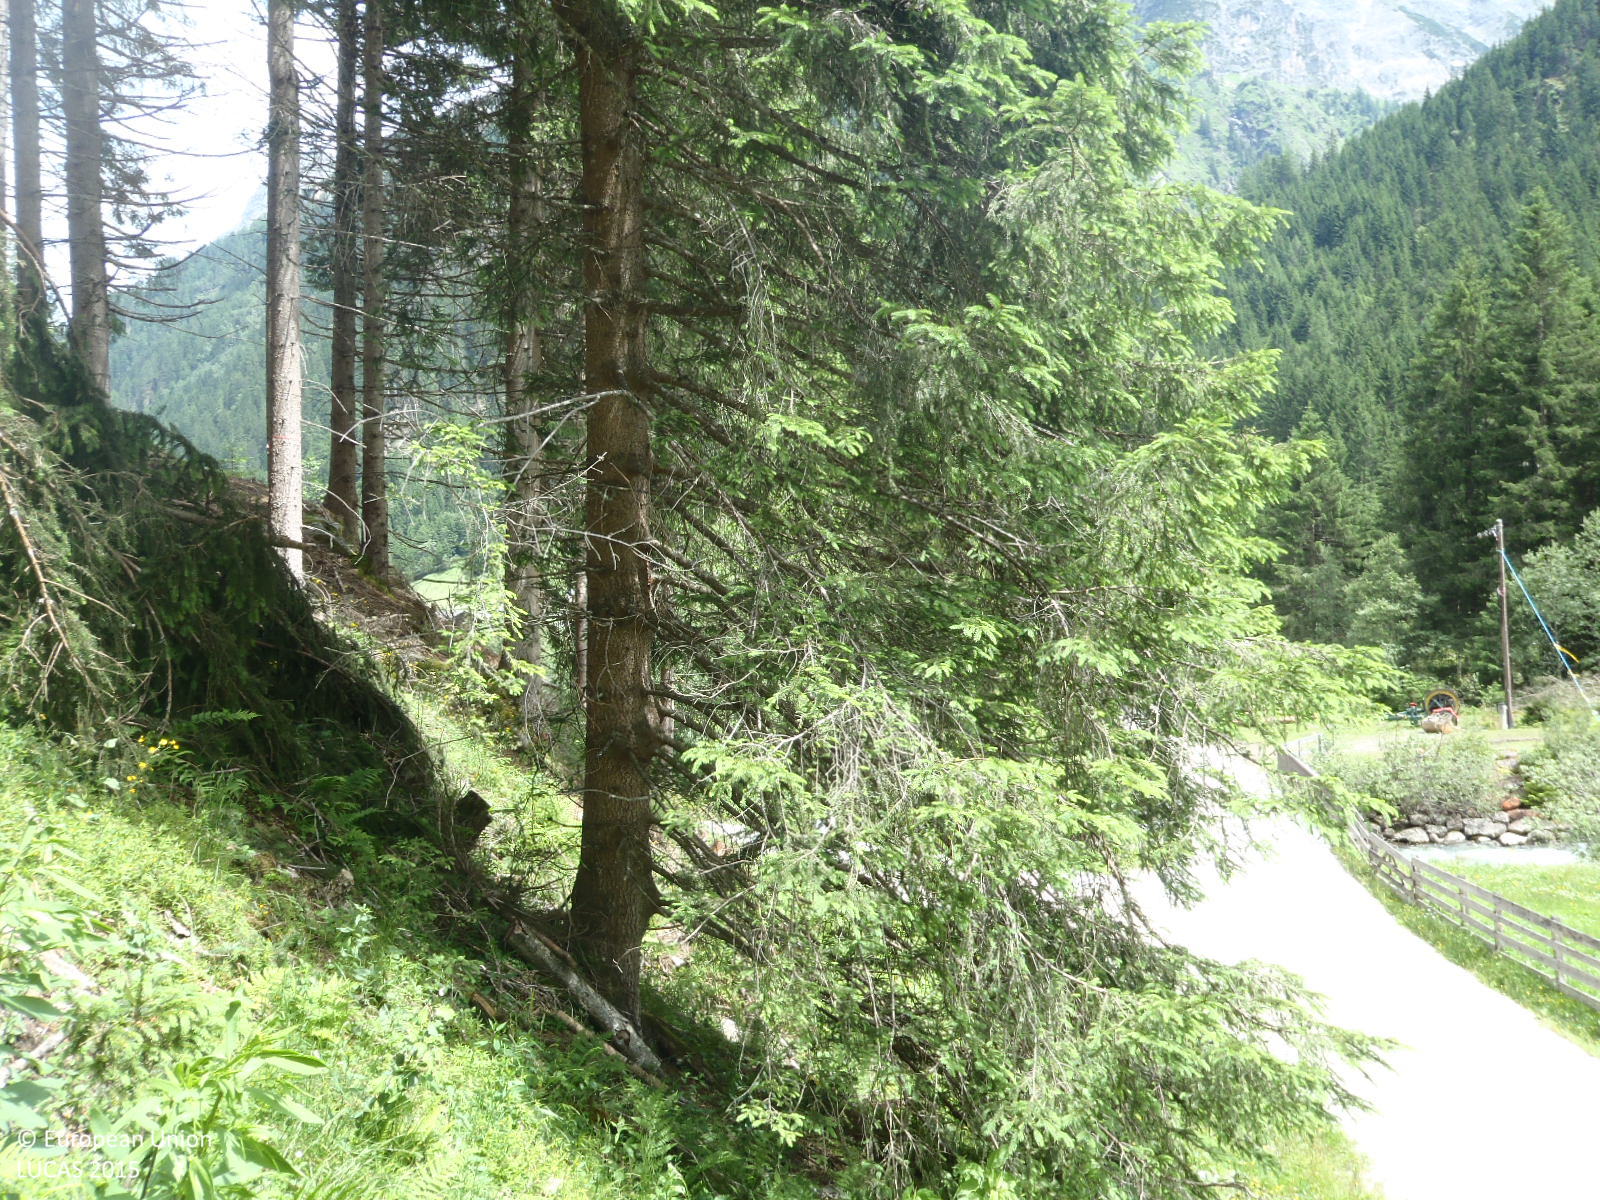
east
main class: Grassland
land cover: Grassland with sparse tree/shrub cover
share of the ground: > 75 %
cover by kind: herbaceous plants 90 %, coniferous forest trees 5 %, shrubs 5 %
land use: Forestry
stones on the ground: 10 - 25 %
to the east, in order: Grassland with sparse tree/shrub cover; Spruce dominated coniferous woodland; Tracks; Shrubland without tree cover; Artificial constructions; Inland fresh running water; Artificial constructions; Broadleaved woodland; Grassland with sparse tree/shrub cover; Broadleaved woodland; Spruce dominated coniferous woodland; Electric lines; Grassland without tree/shrub cover; Artificial constructions in urban areas; Paved roads, cycling and walking lanes; Fences; Grassland without tree/shrub cover
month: June
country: AT
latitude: 47.0274
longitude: 11.3276
